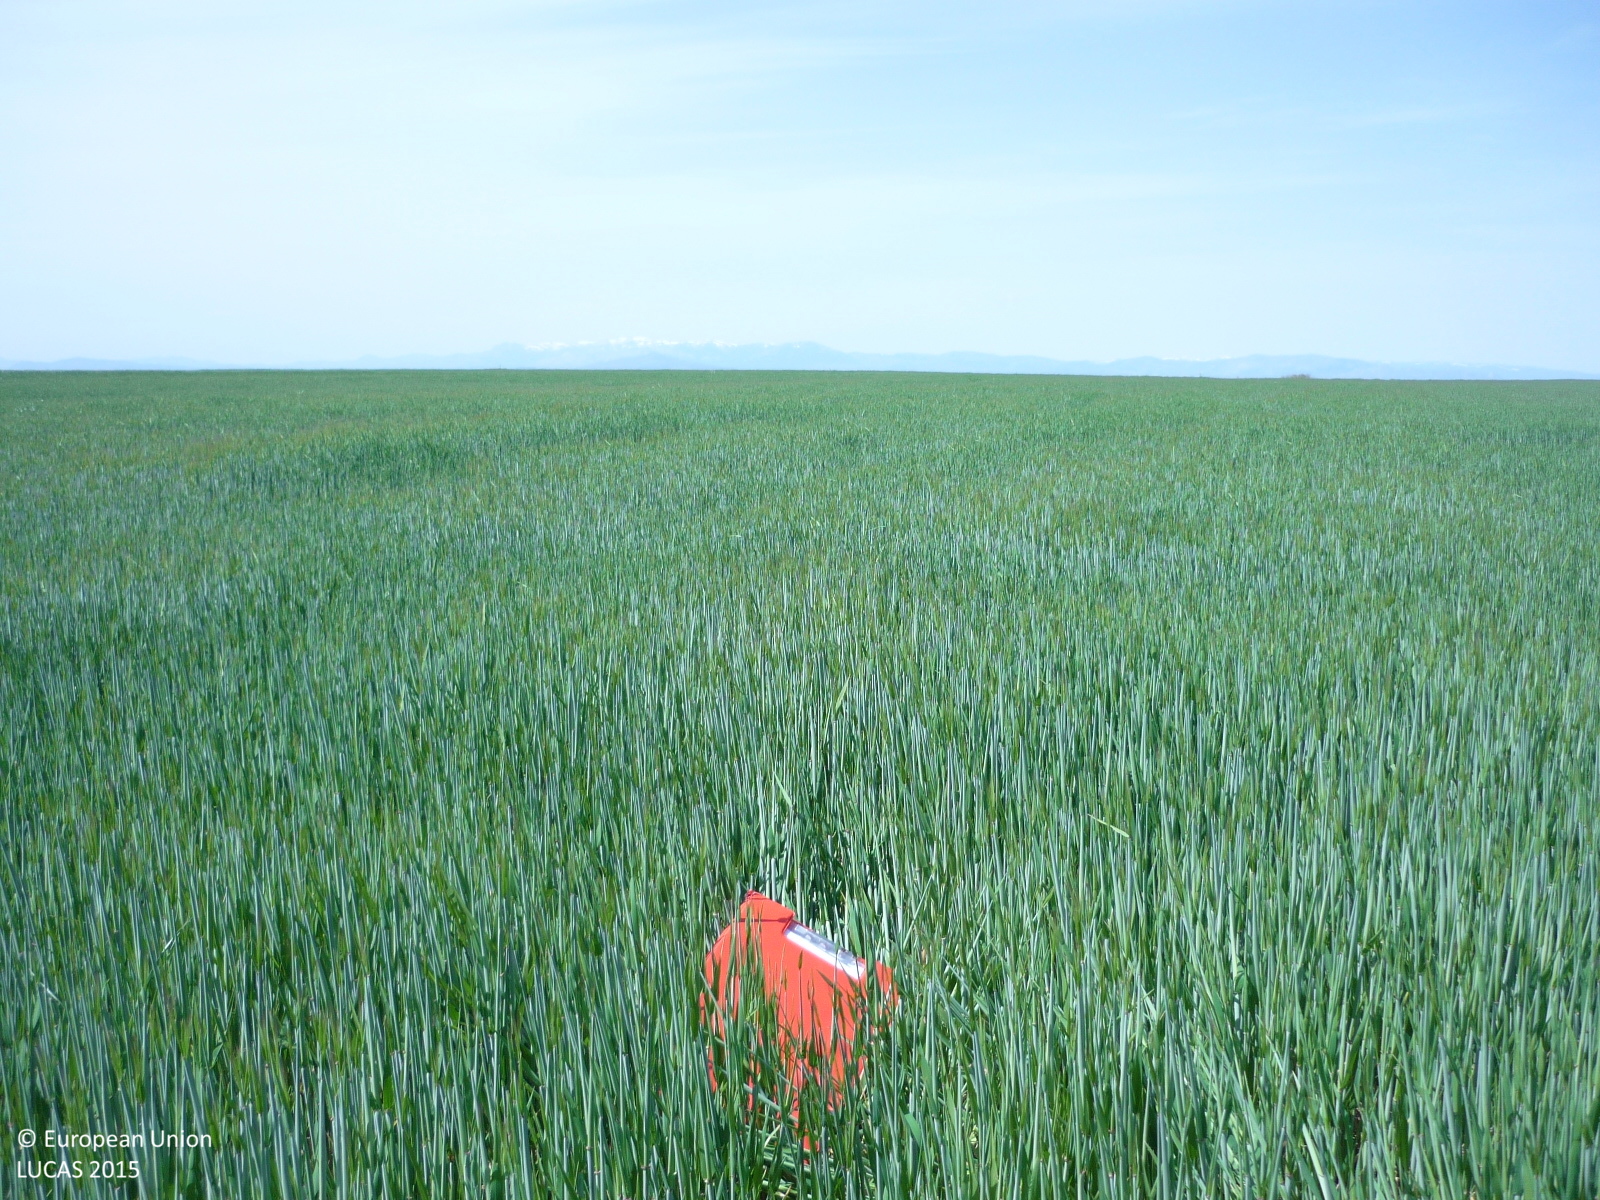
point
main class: Cropland
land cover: Common wheat
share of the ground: > 75 %
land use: Agriculture (excluding fallow land and kitchen gardens)
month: April
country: ES
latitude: 40.5982
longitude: -3.3291
